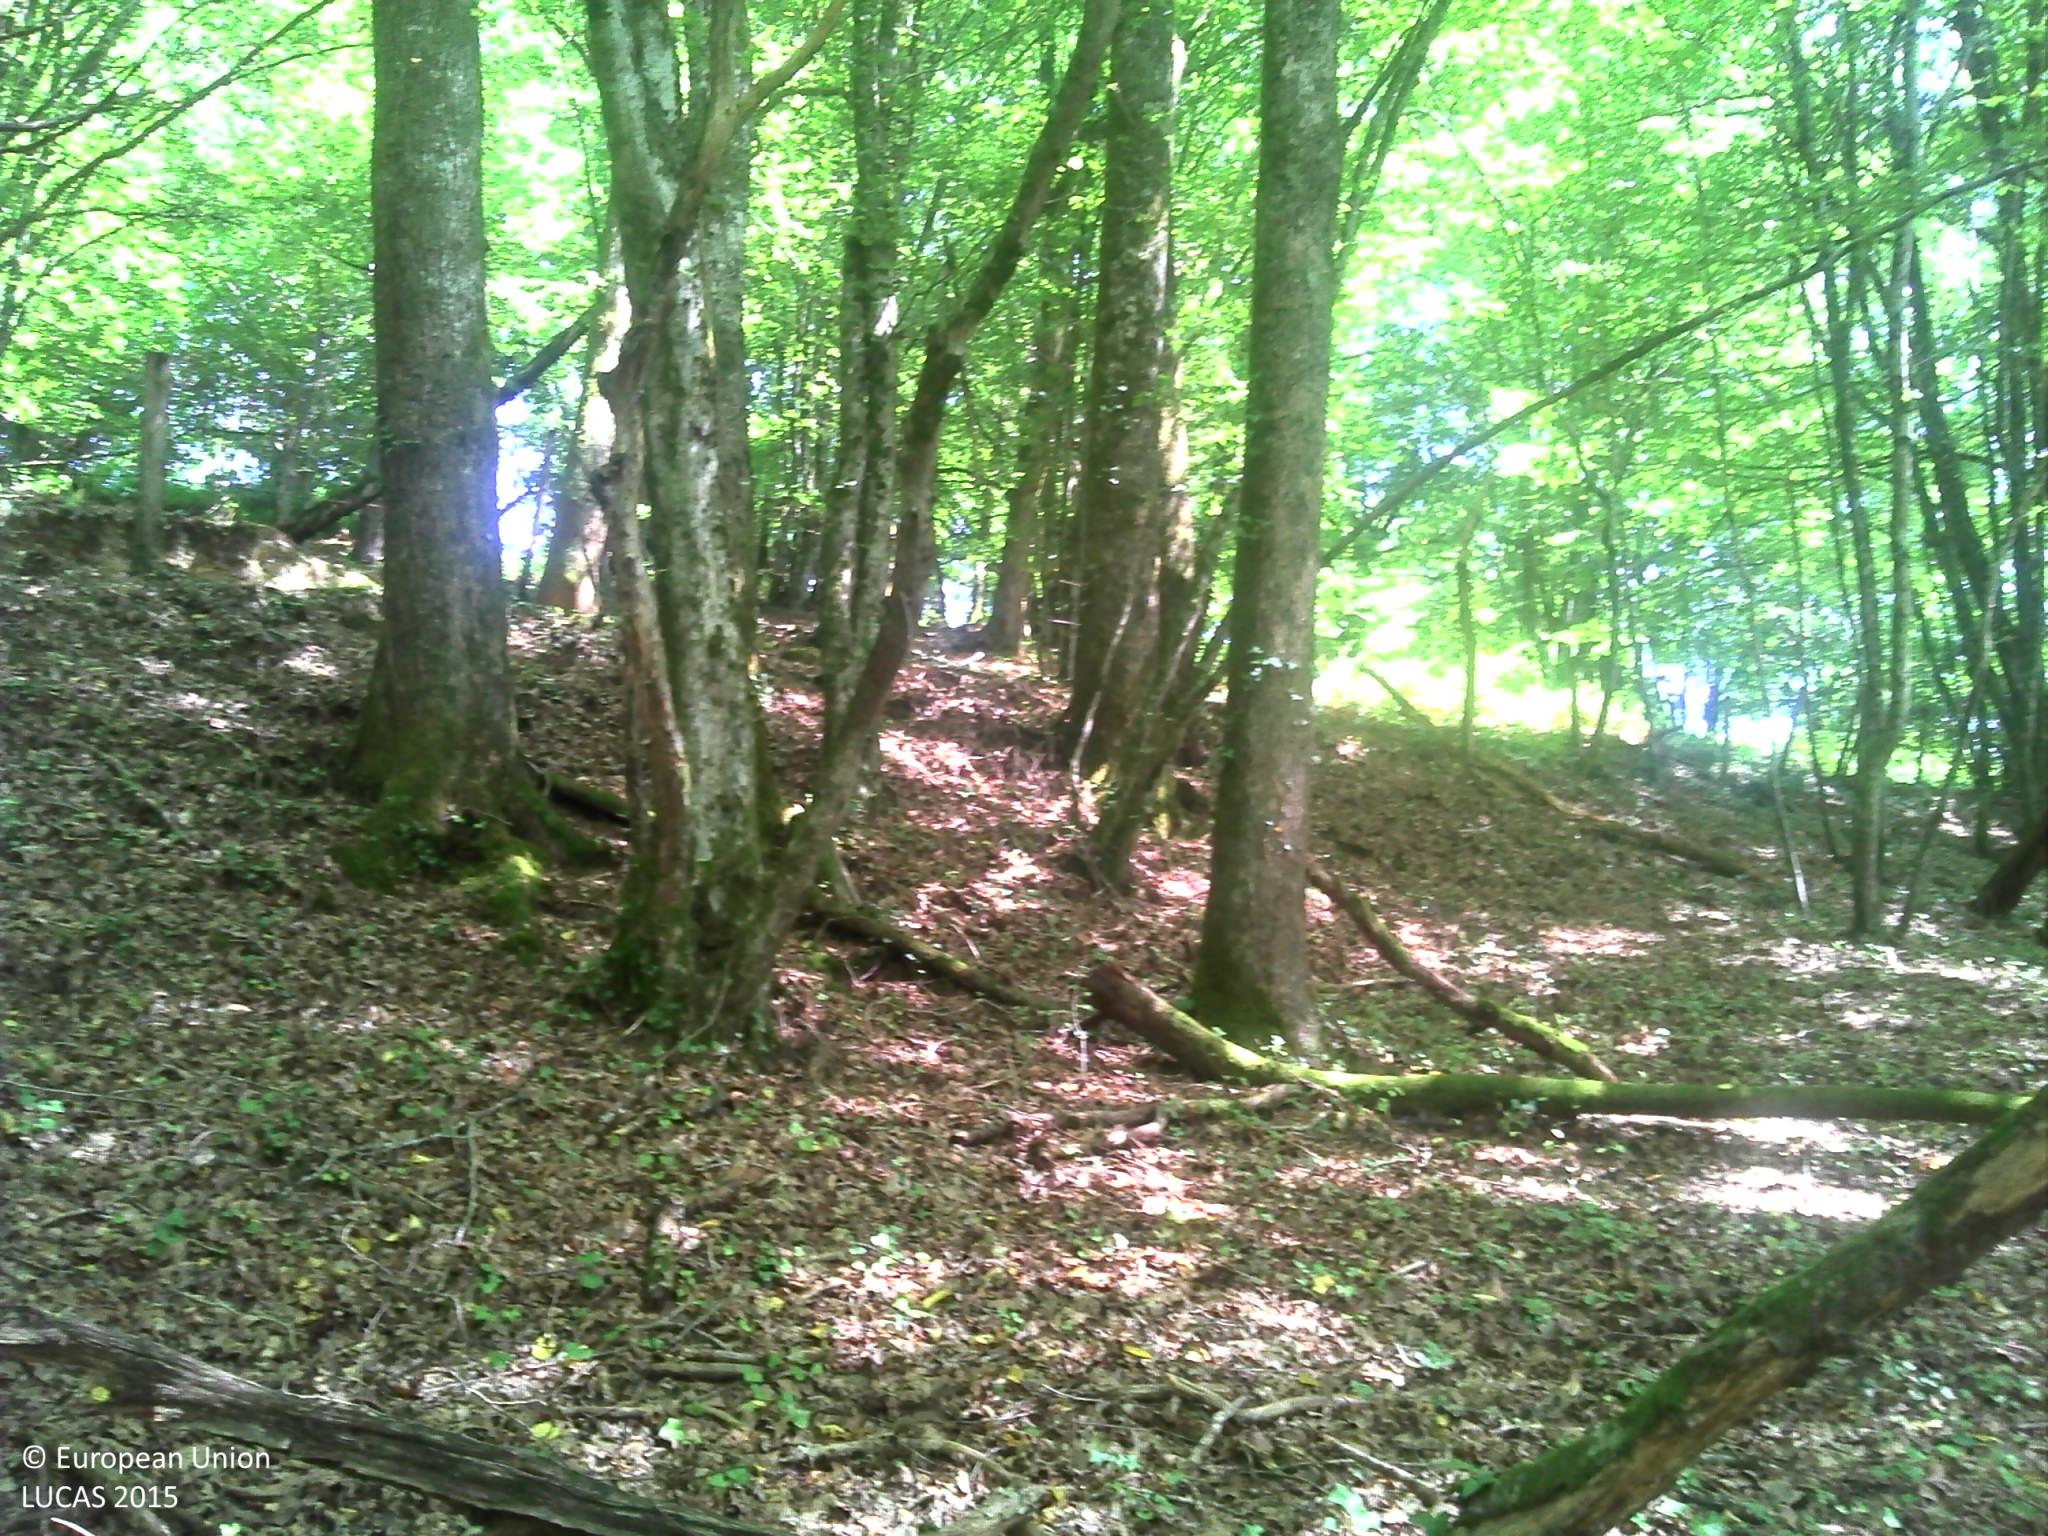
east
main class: Woodland
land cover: Broadleaved woodland
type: mesophytic deciduous forest
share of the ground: 50 - 75 %
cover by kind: broadleaved forest trees 70 %, herbaceous plants 20 %, lichens and mosses 10 %
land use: Forestry
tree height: > 5 m
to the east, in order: Broadleaved woodland; Fences; Tracks; Broadleaved woodland; Tracks; Grassland with sparse tree/shrub cover; Tracks; Grass margins; Fences; Grassland with sparse tree/shrub cover; Broadleaved woodland; Fences; Grassland without tree/shrub cover; Lines of trees; Abandoned hedges; Grass margins; Fences; Grassland without tree/shrub cover
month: August
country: FR
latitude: 45.2555
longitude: 1.5466
